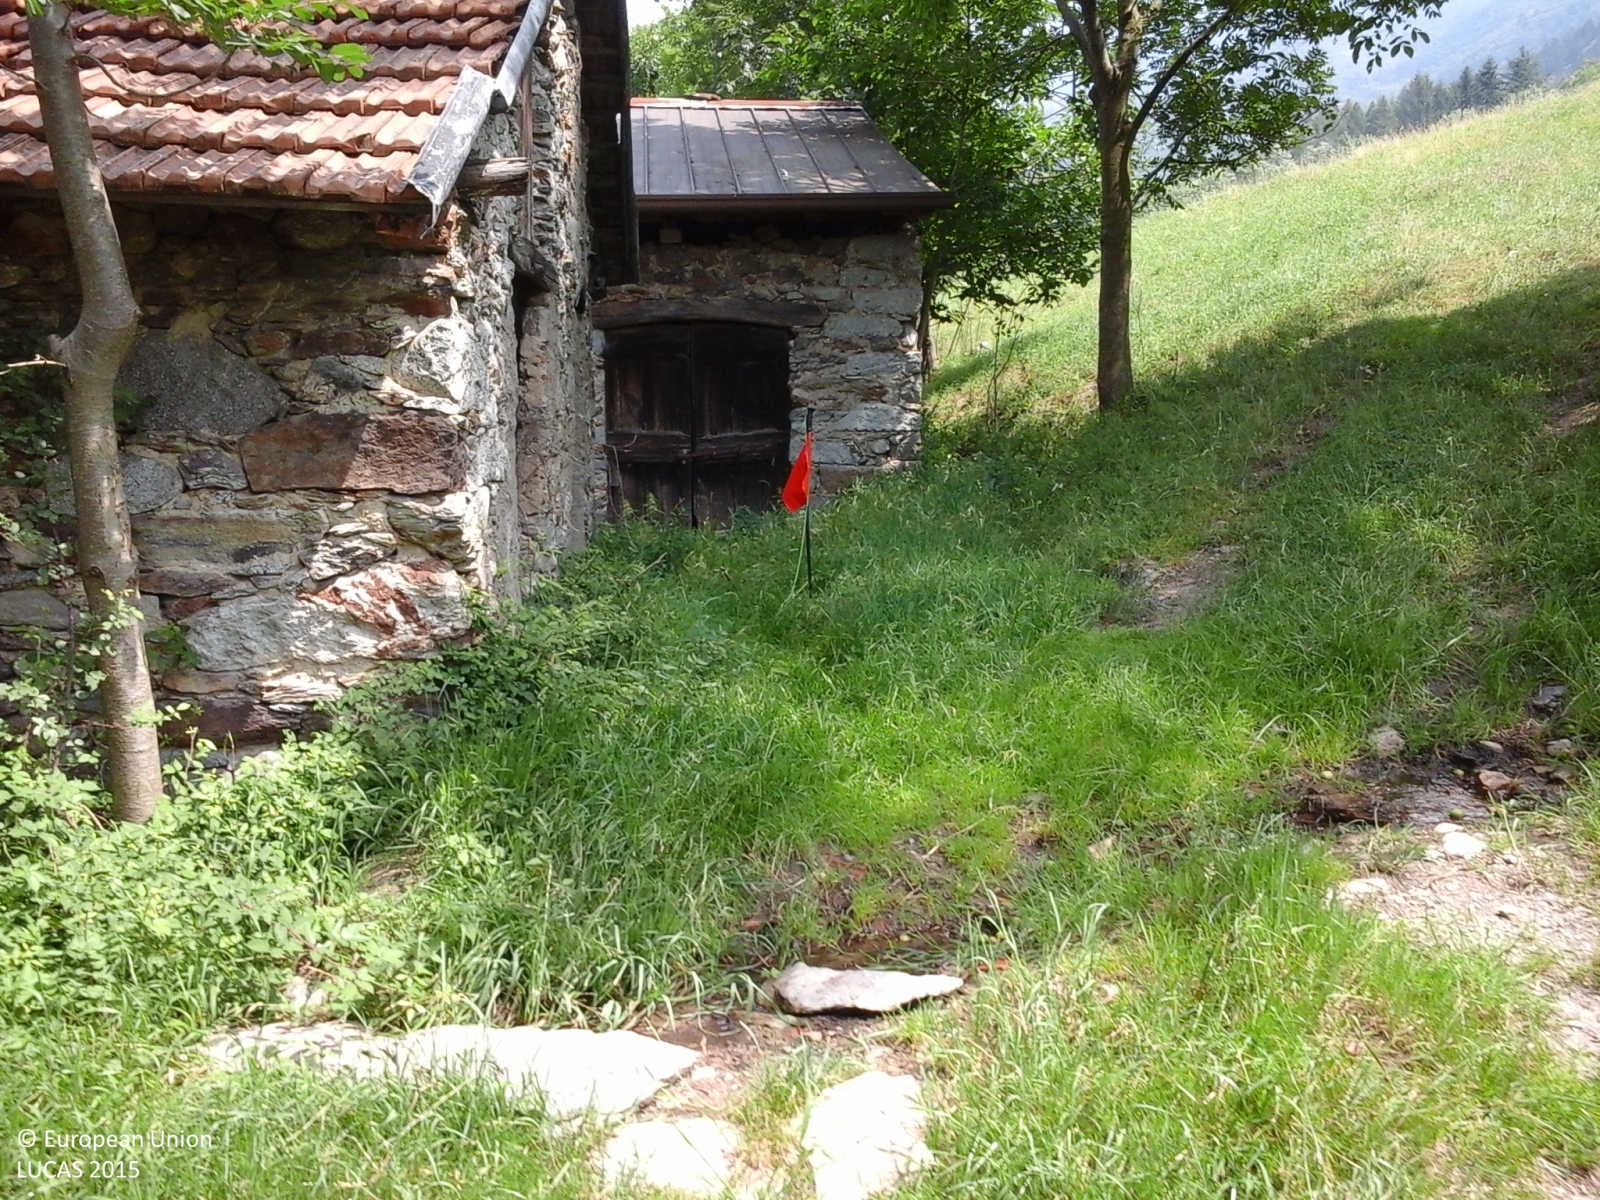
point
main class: Grassland
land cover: Grassland with sparse tree/shrub cover
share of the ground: > 75 %
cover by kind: herbaceous plants 95 %, broadleaved forest trees 5 %
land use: Agriculture (excluding fallow land and kitchen gardens)
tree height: > 5 m
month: July
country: IT
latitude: 46.1165
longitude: 10.3230
